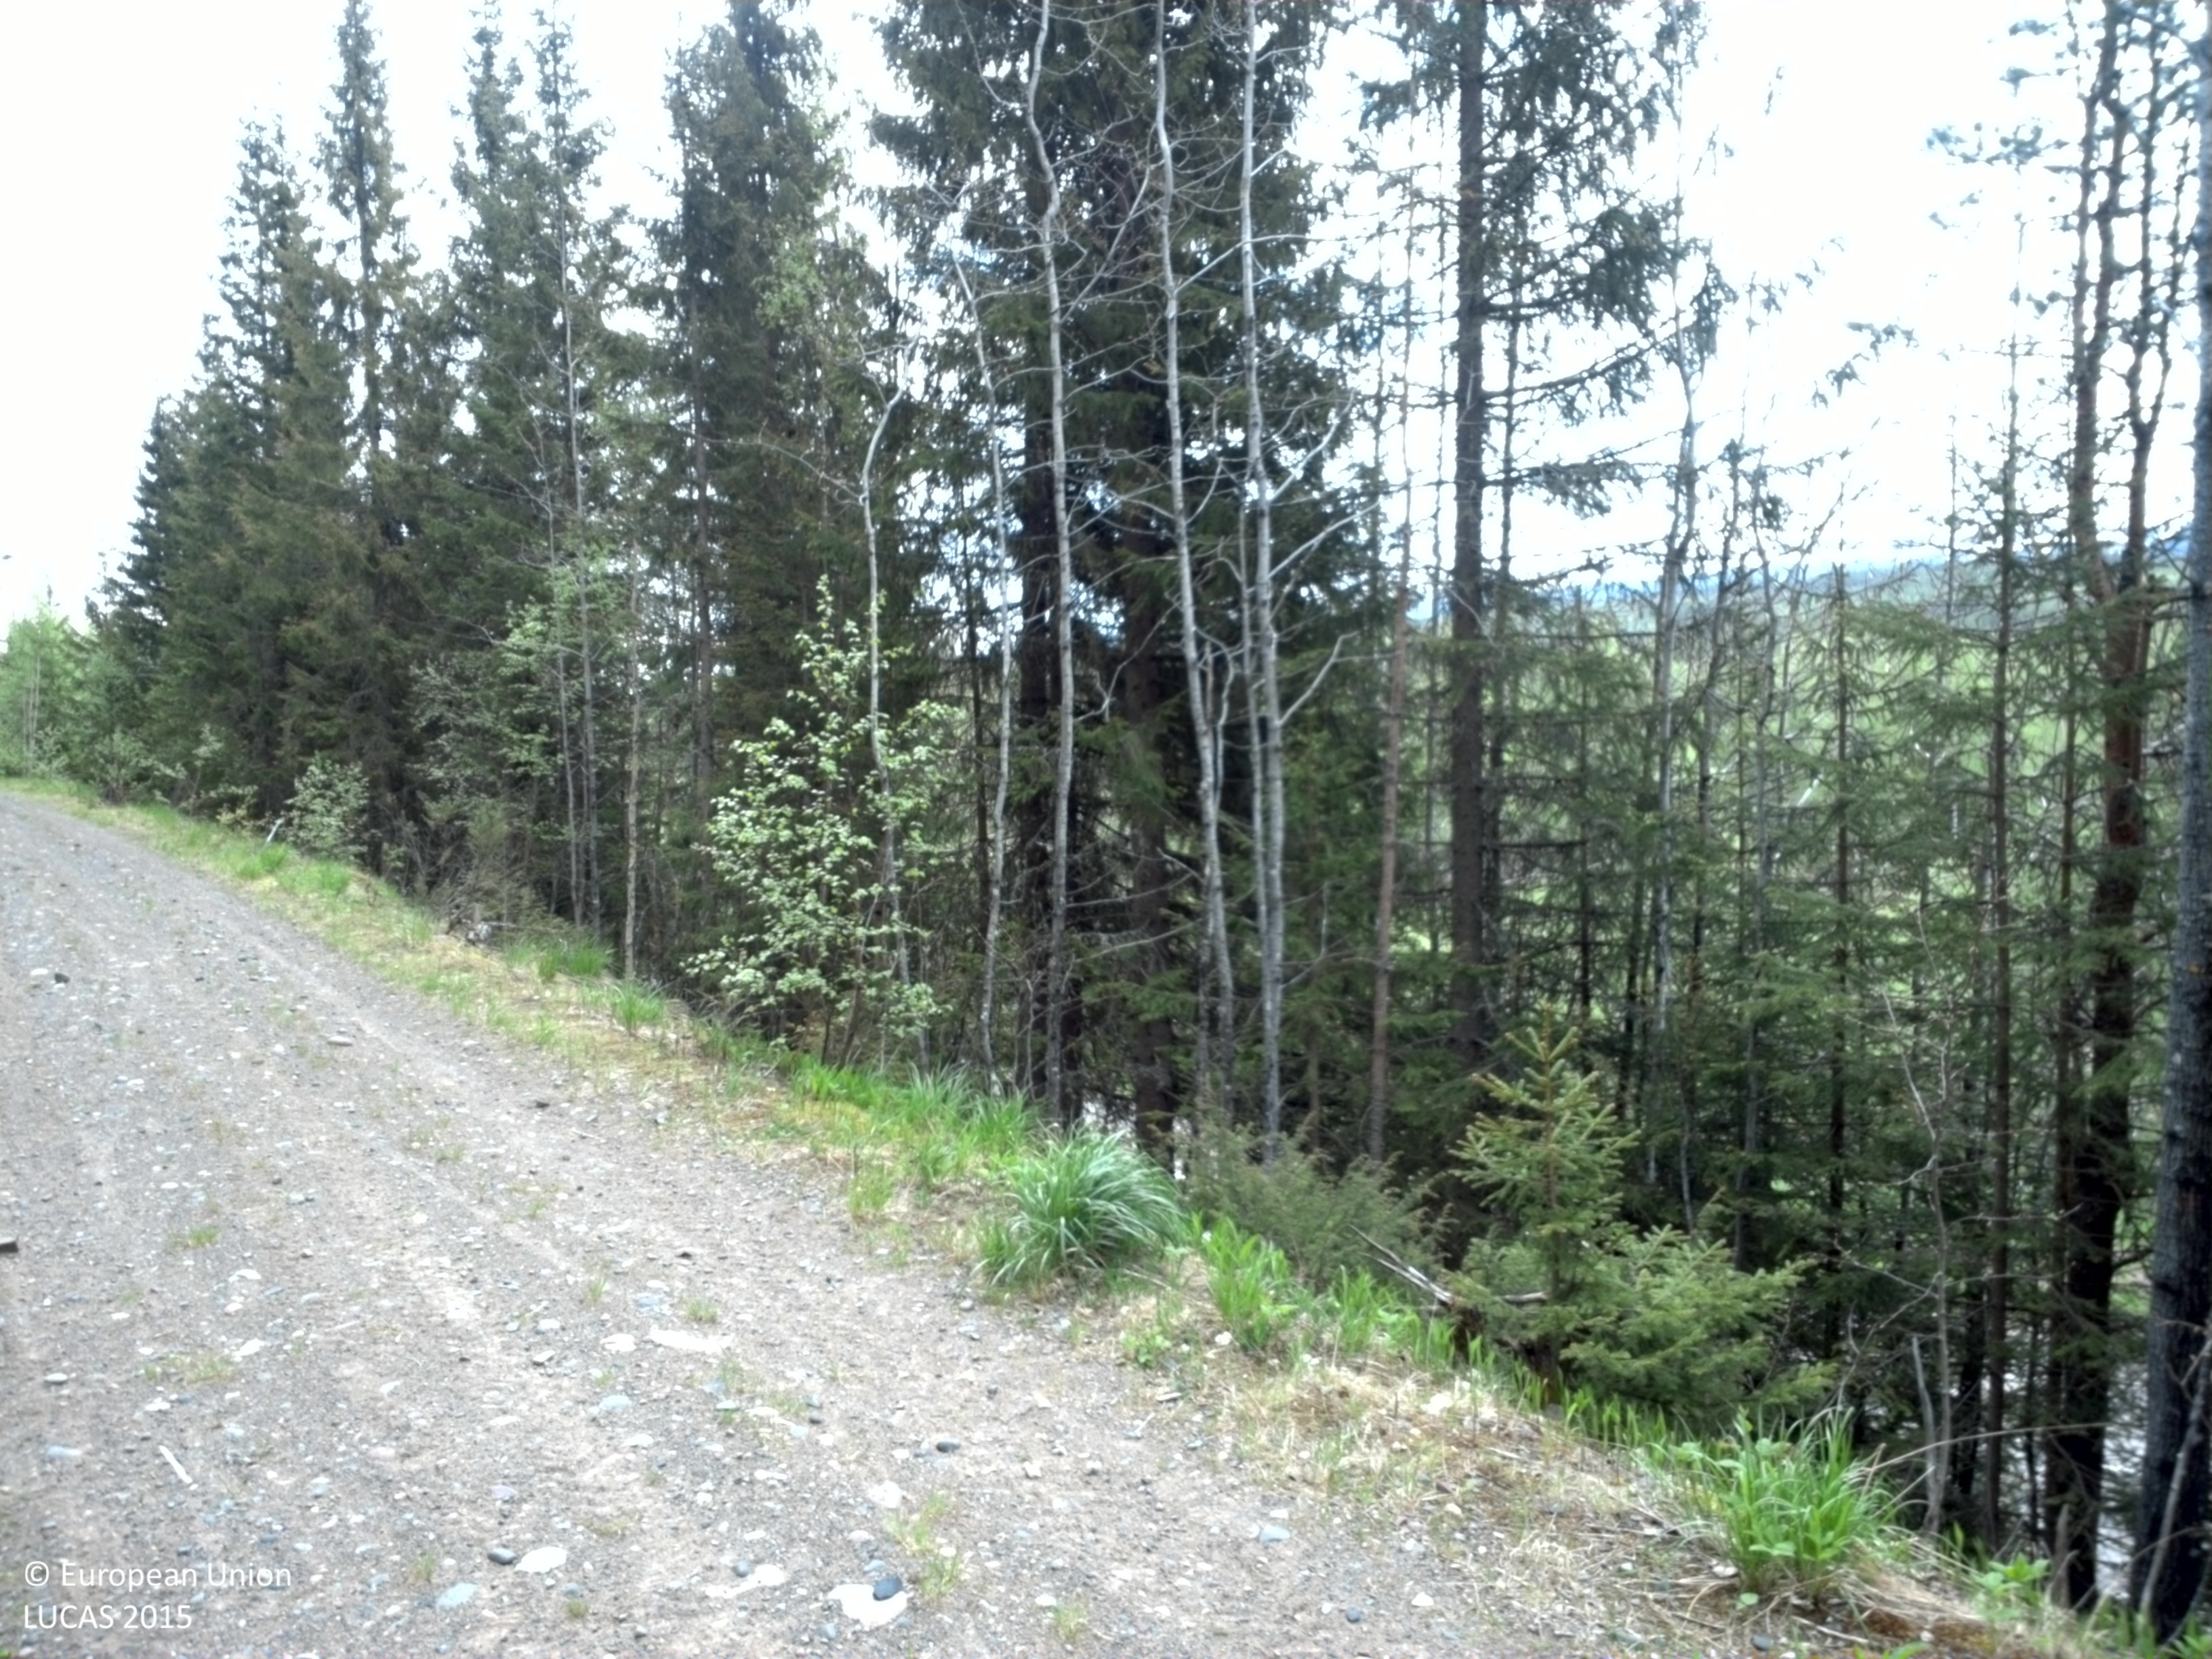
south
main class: Woodland
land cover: Other mixed woodland
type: boreal forest
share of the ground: > 75 %
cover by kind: coniferous forest trees 50 %, broadleaved forest trees 40 %, herbaceous plants 10 %
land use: Forestry
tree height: > 5 m
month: June
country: SE
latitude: 61.1886
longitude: 13.2439
